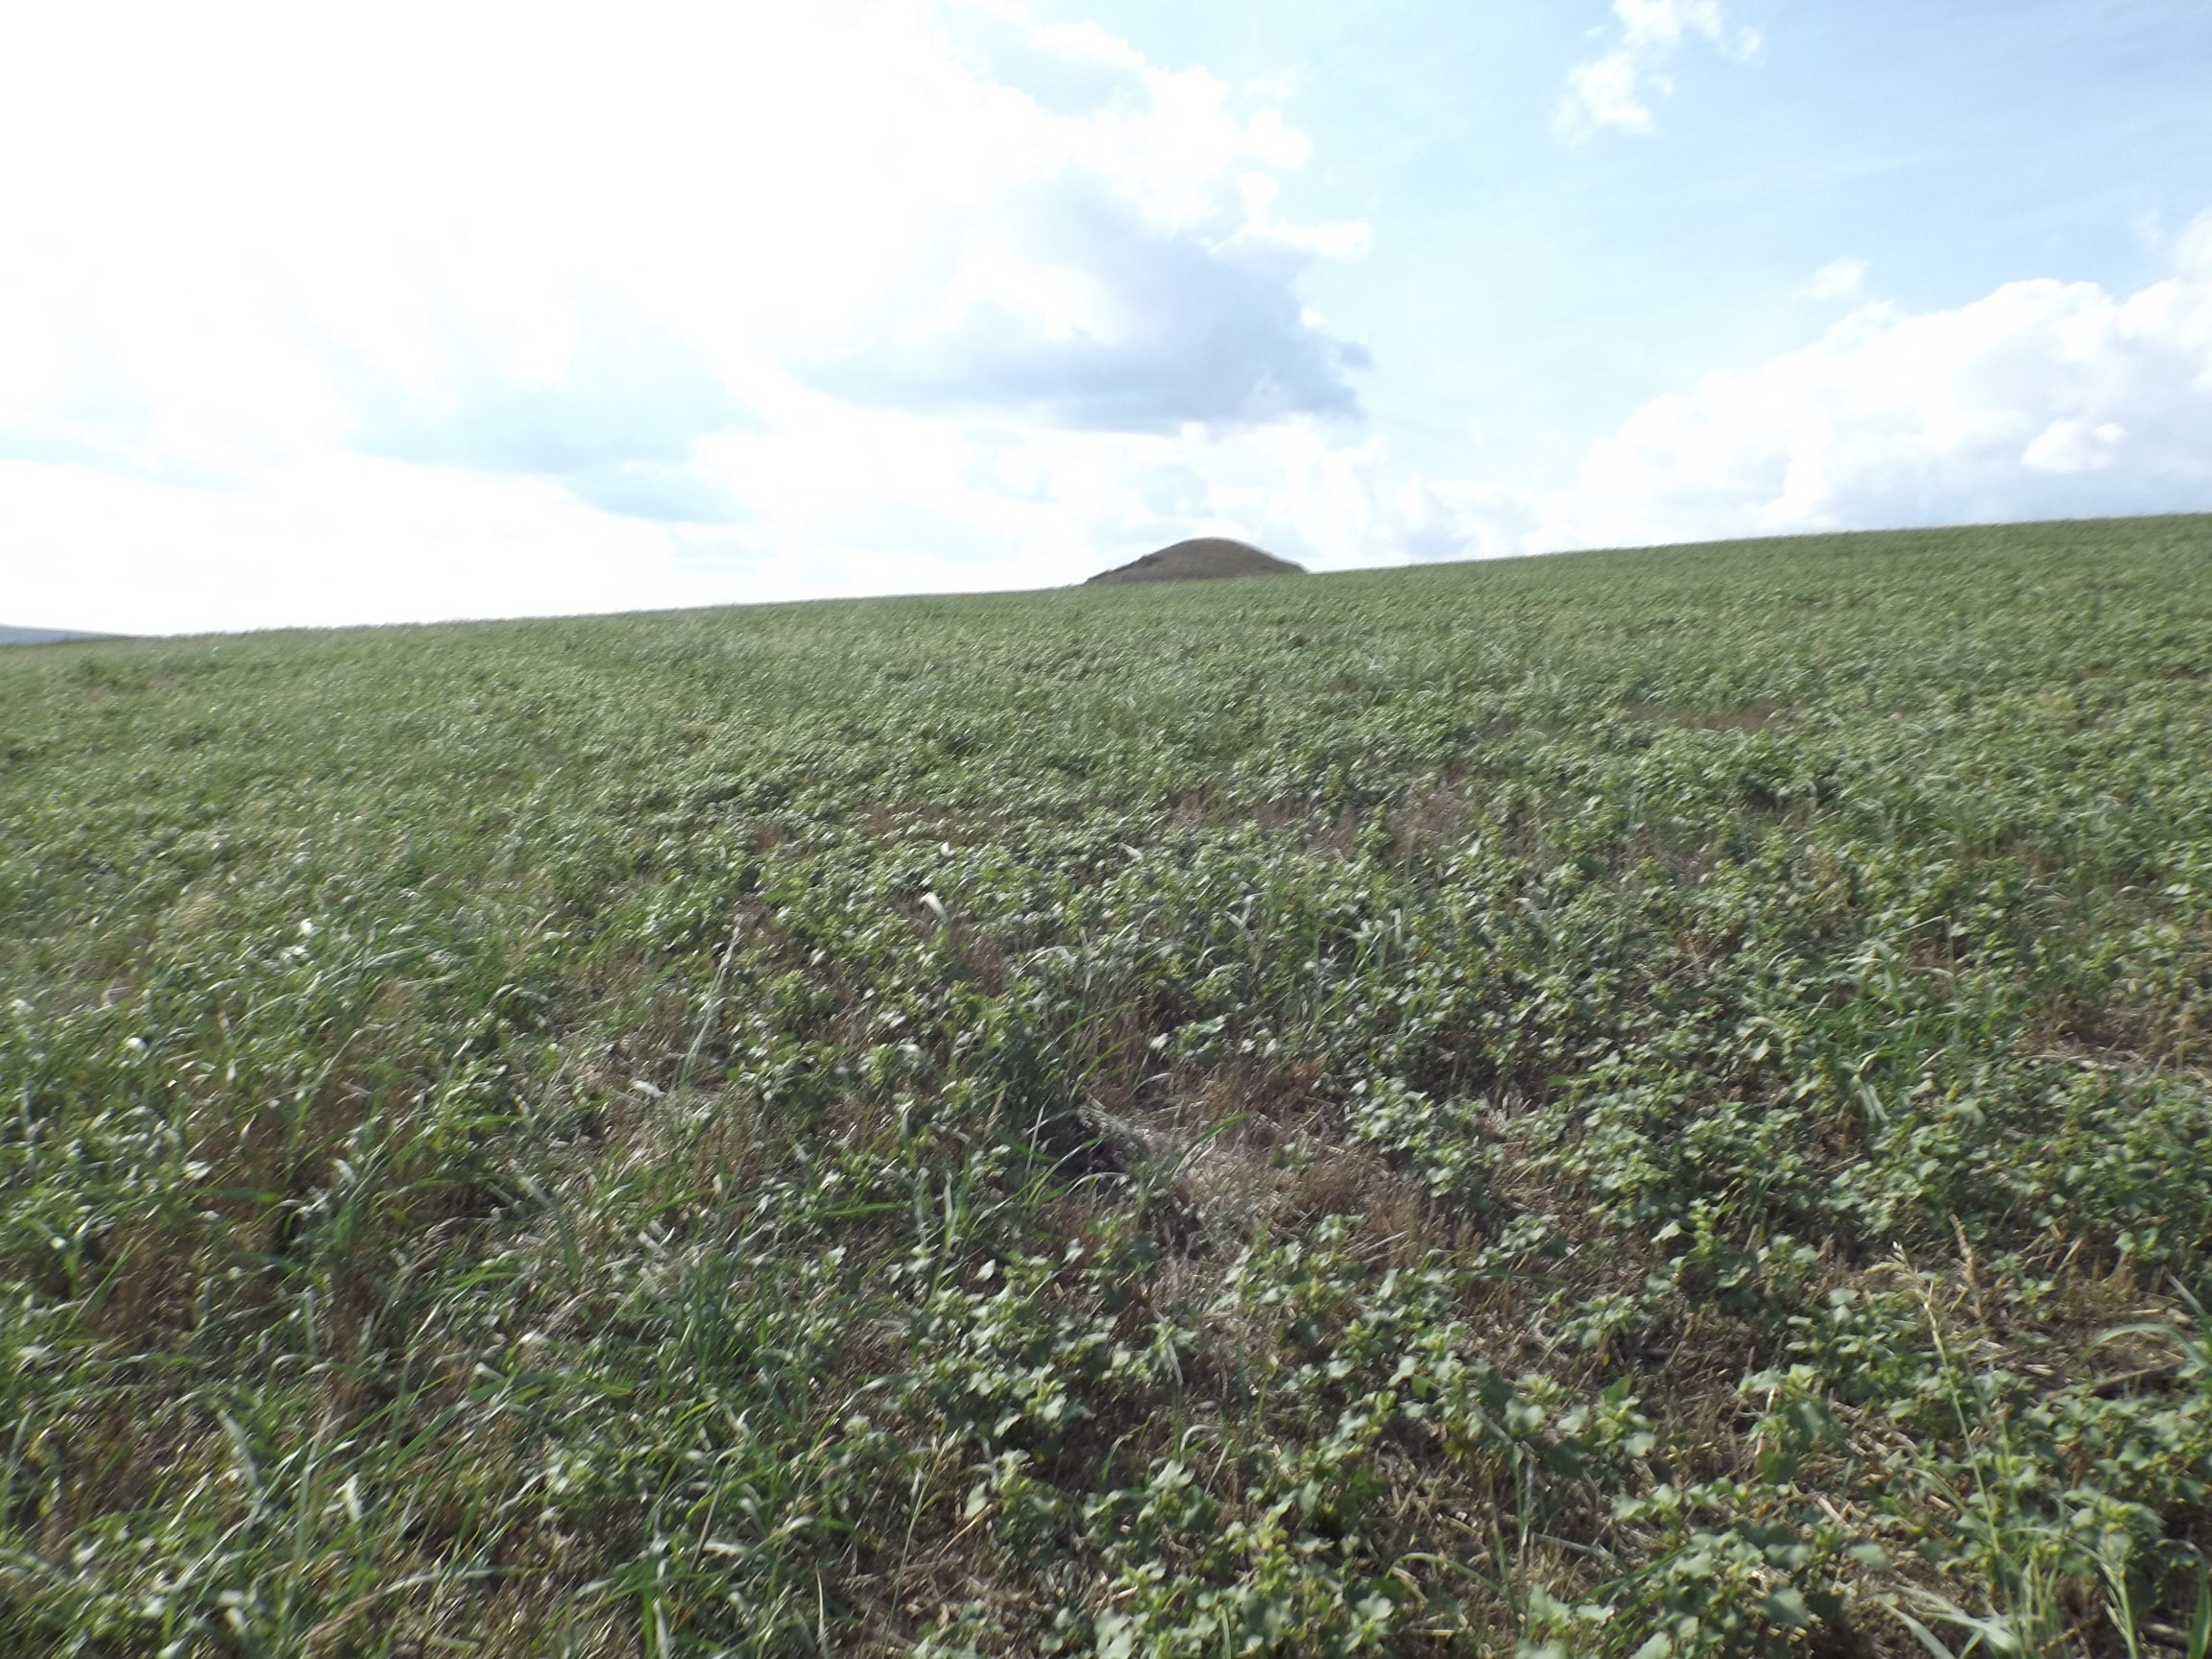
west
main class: Cropland
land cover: Common wheat
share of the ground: < 10 %
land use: Agriculture (excluding fallow land and kitchen gardens)
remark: Harvested field
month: September
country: BG
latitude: 43.2698
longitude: 27.4117
